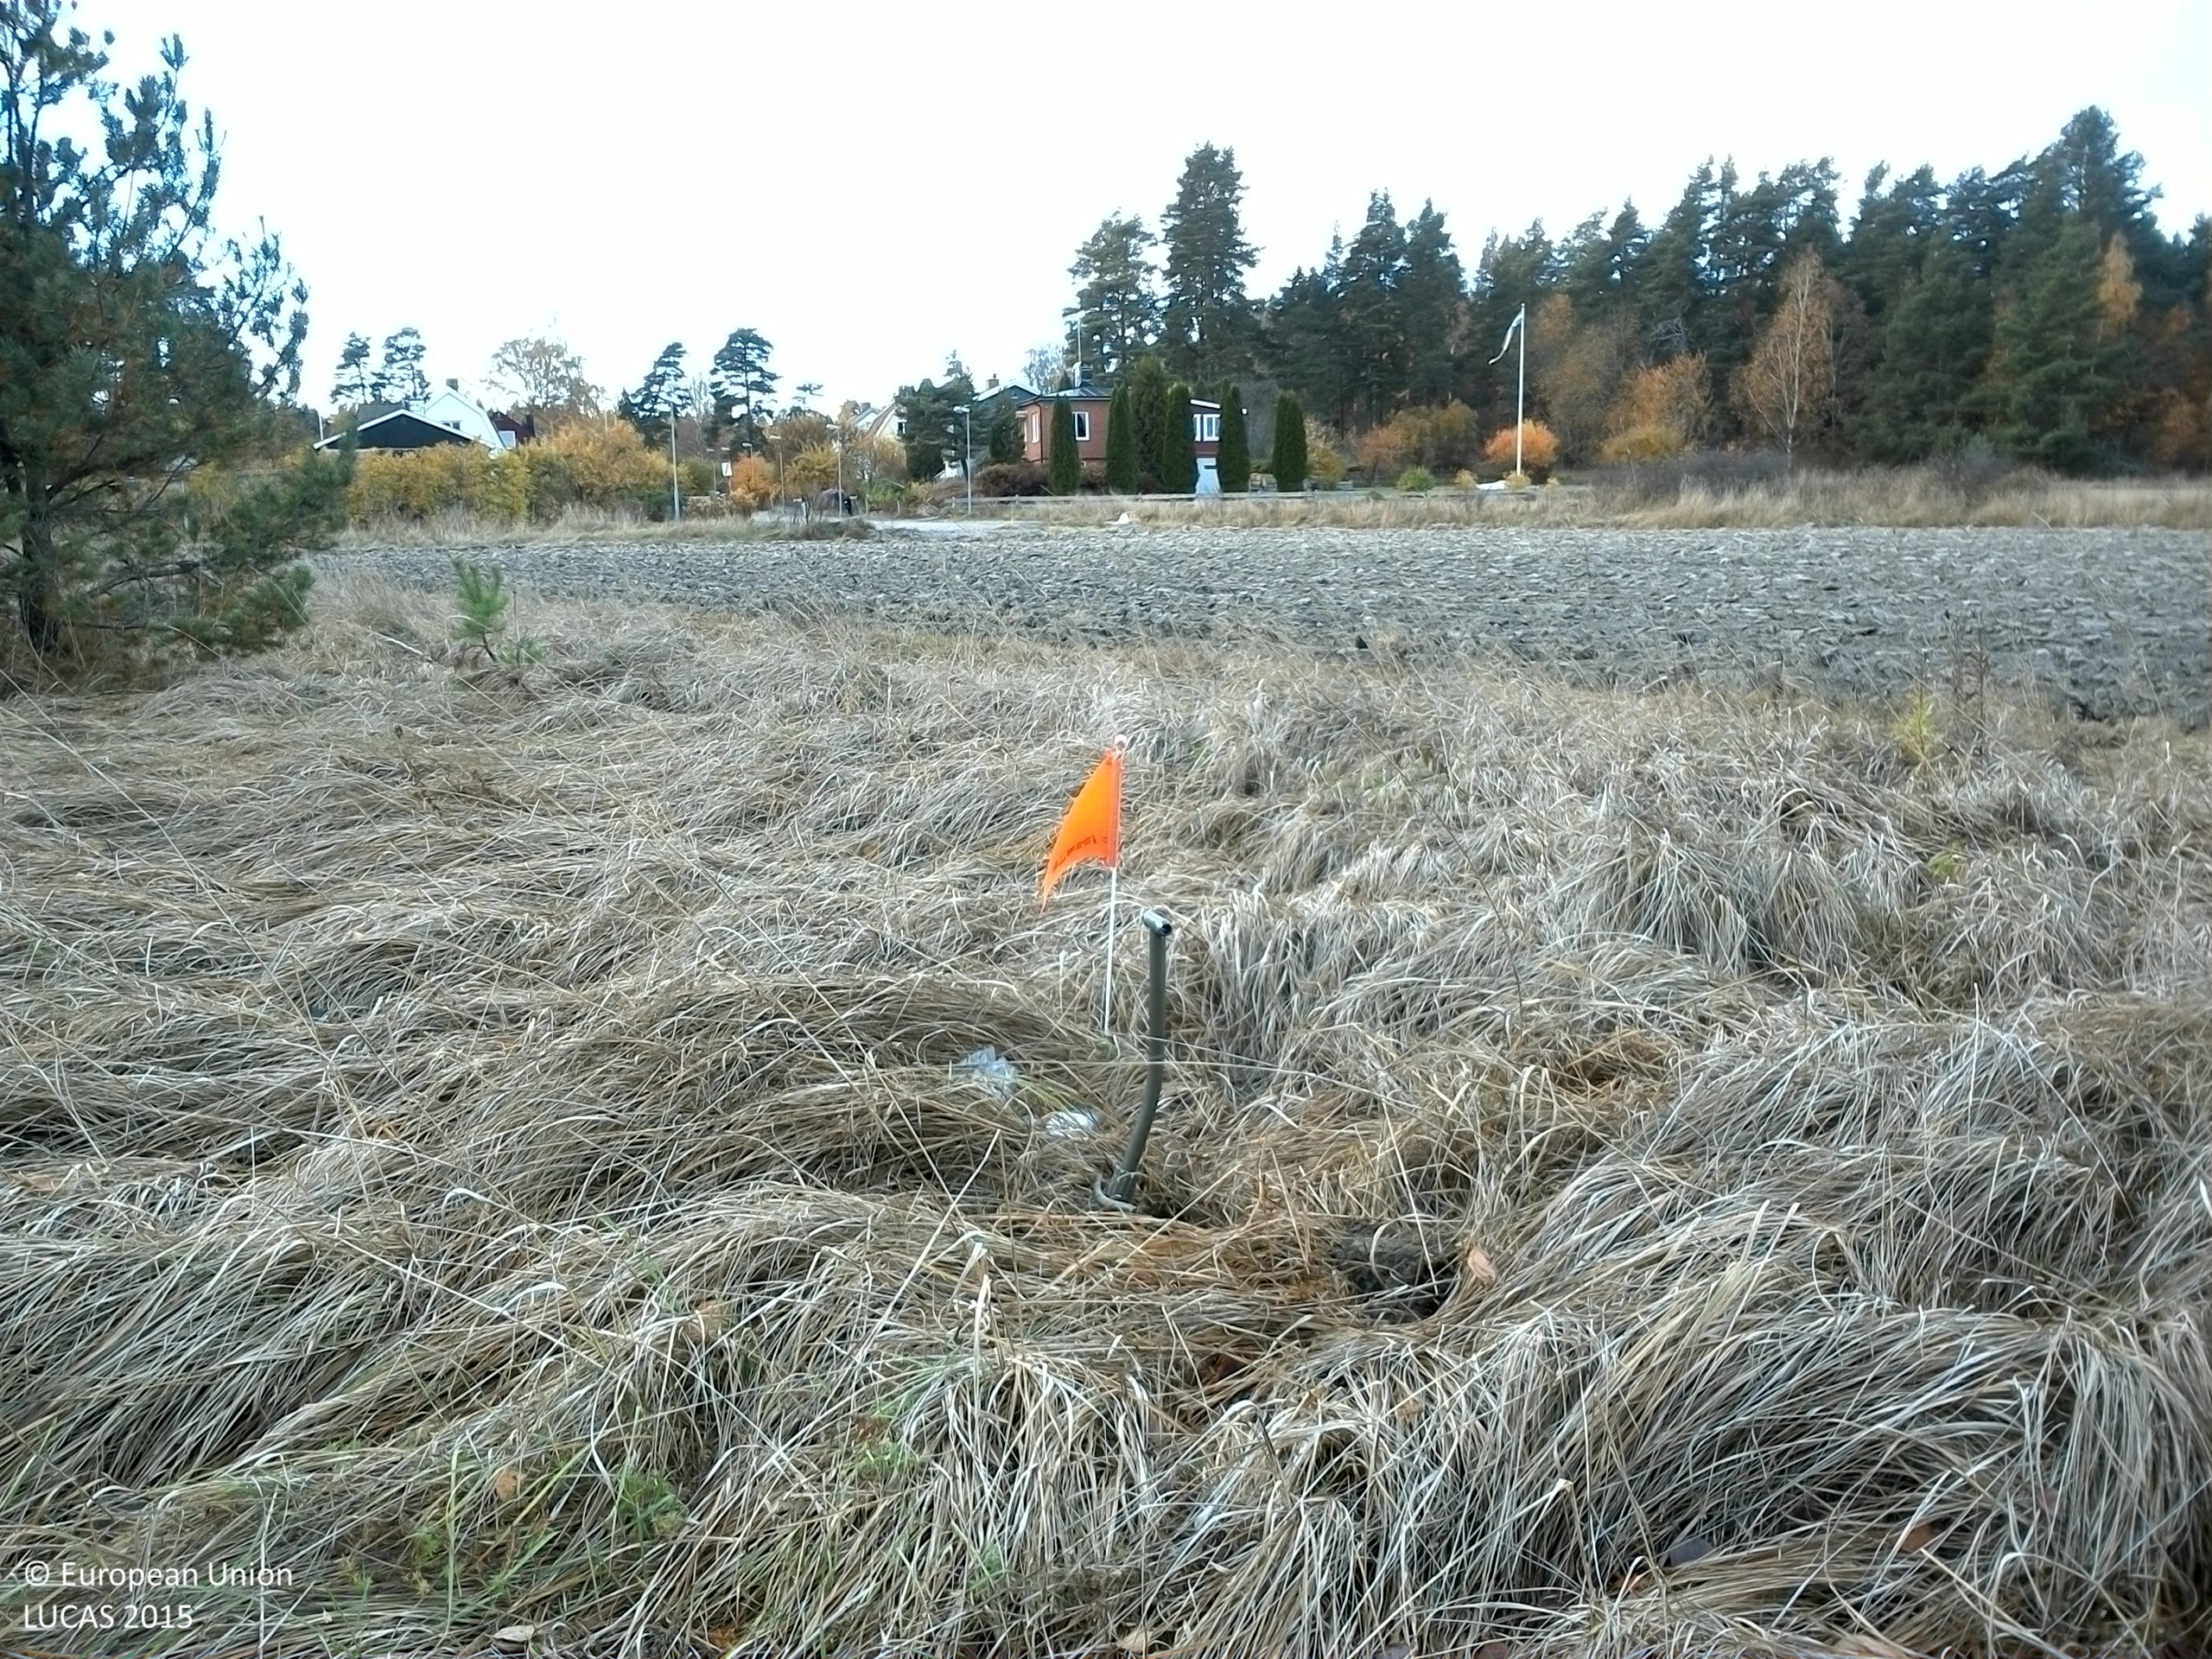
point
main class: Grassland
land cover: Grassland with sparse tree/shrub cover
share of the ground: > 75 %
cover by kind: herbaceous plants 95 %, coniferous forest trees 5 %
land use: Semi-natural and natural areas not in use
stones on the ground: < 10 %
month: October
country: SE
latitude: 59.3777
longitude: 16.5582
